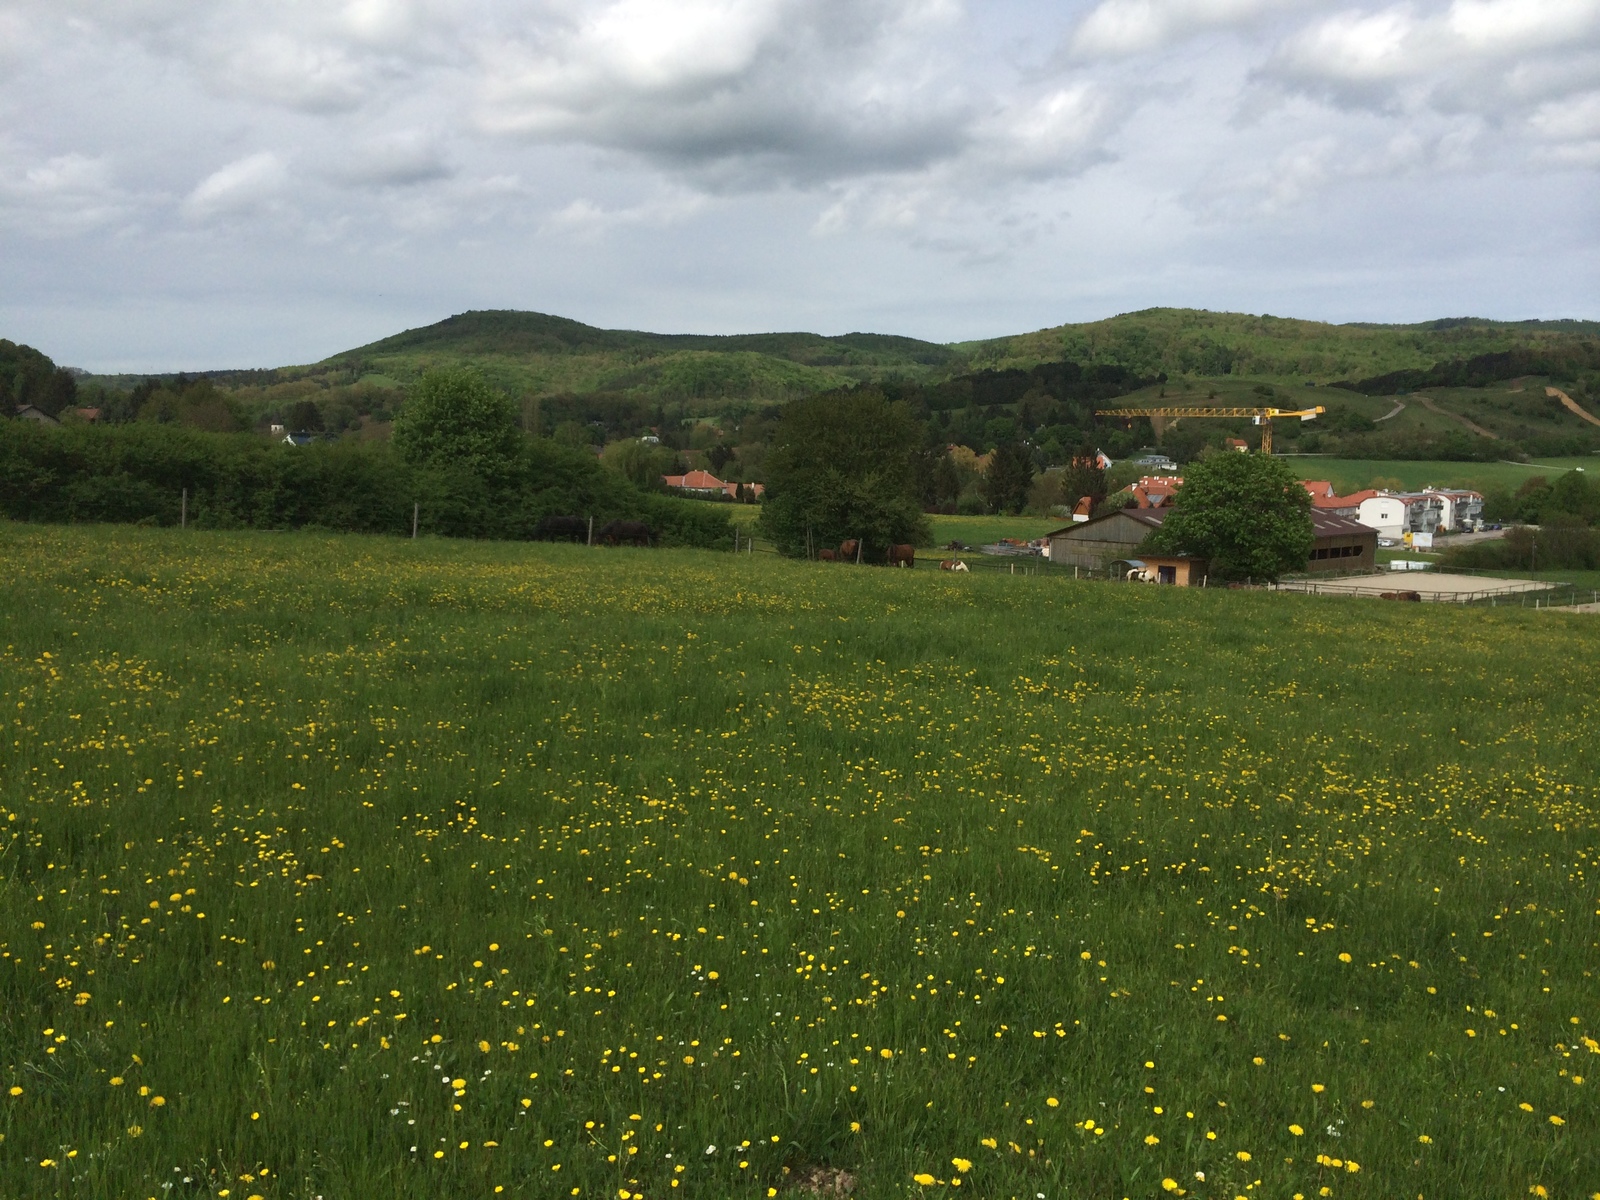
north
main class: Grassland
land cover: Grassland without tree/shrub cover
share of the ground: > 75 %
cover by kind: herbaceous plants 100 %
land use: Agriculture (excluding fallow land and kitchen gardens)
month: May
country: AT
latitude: 48.0691
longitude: 16.1640
